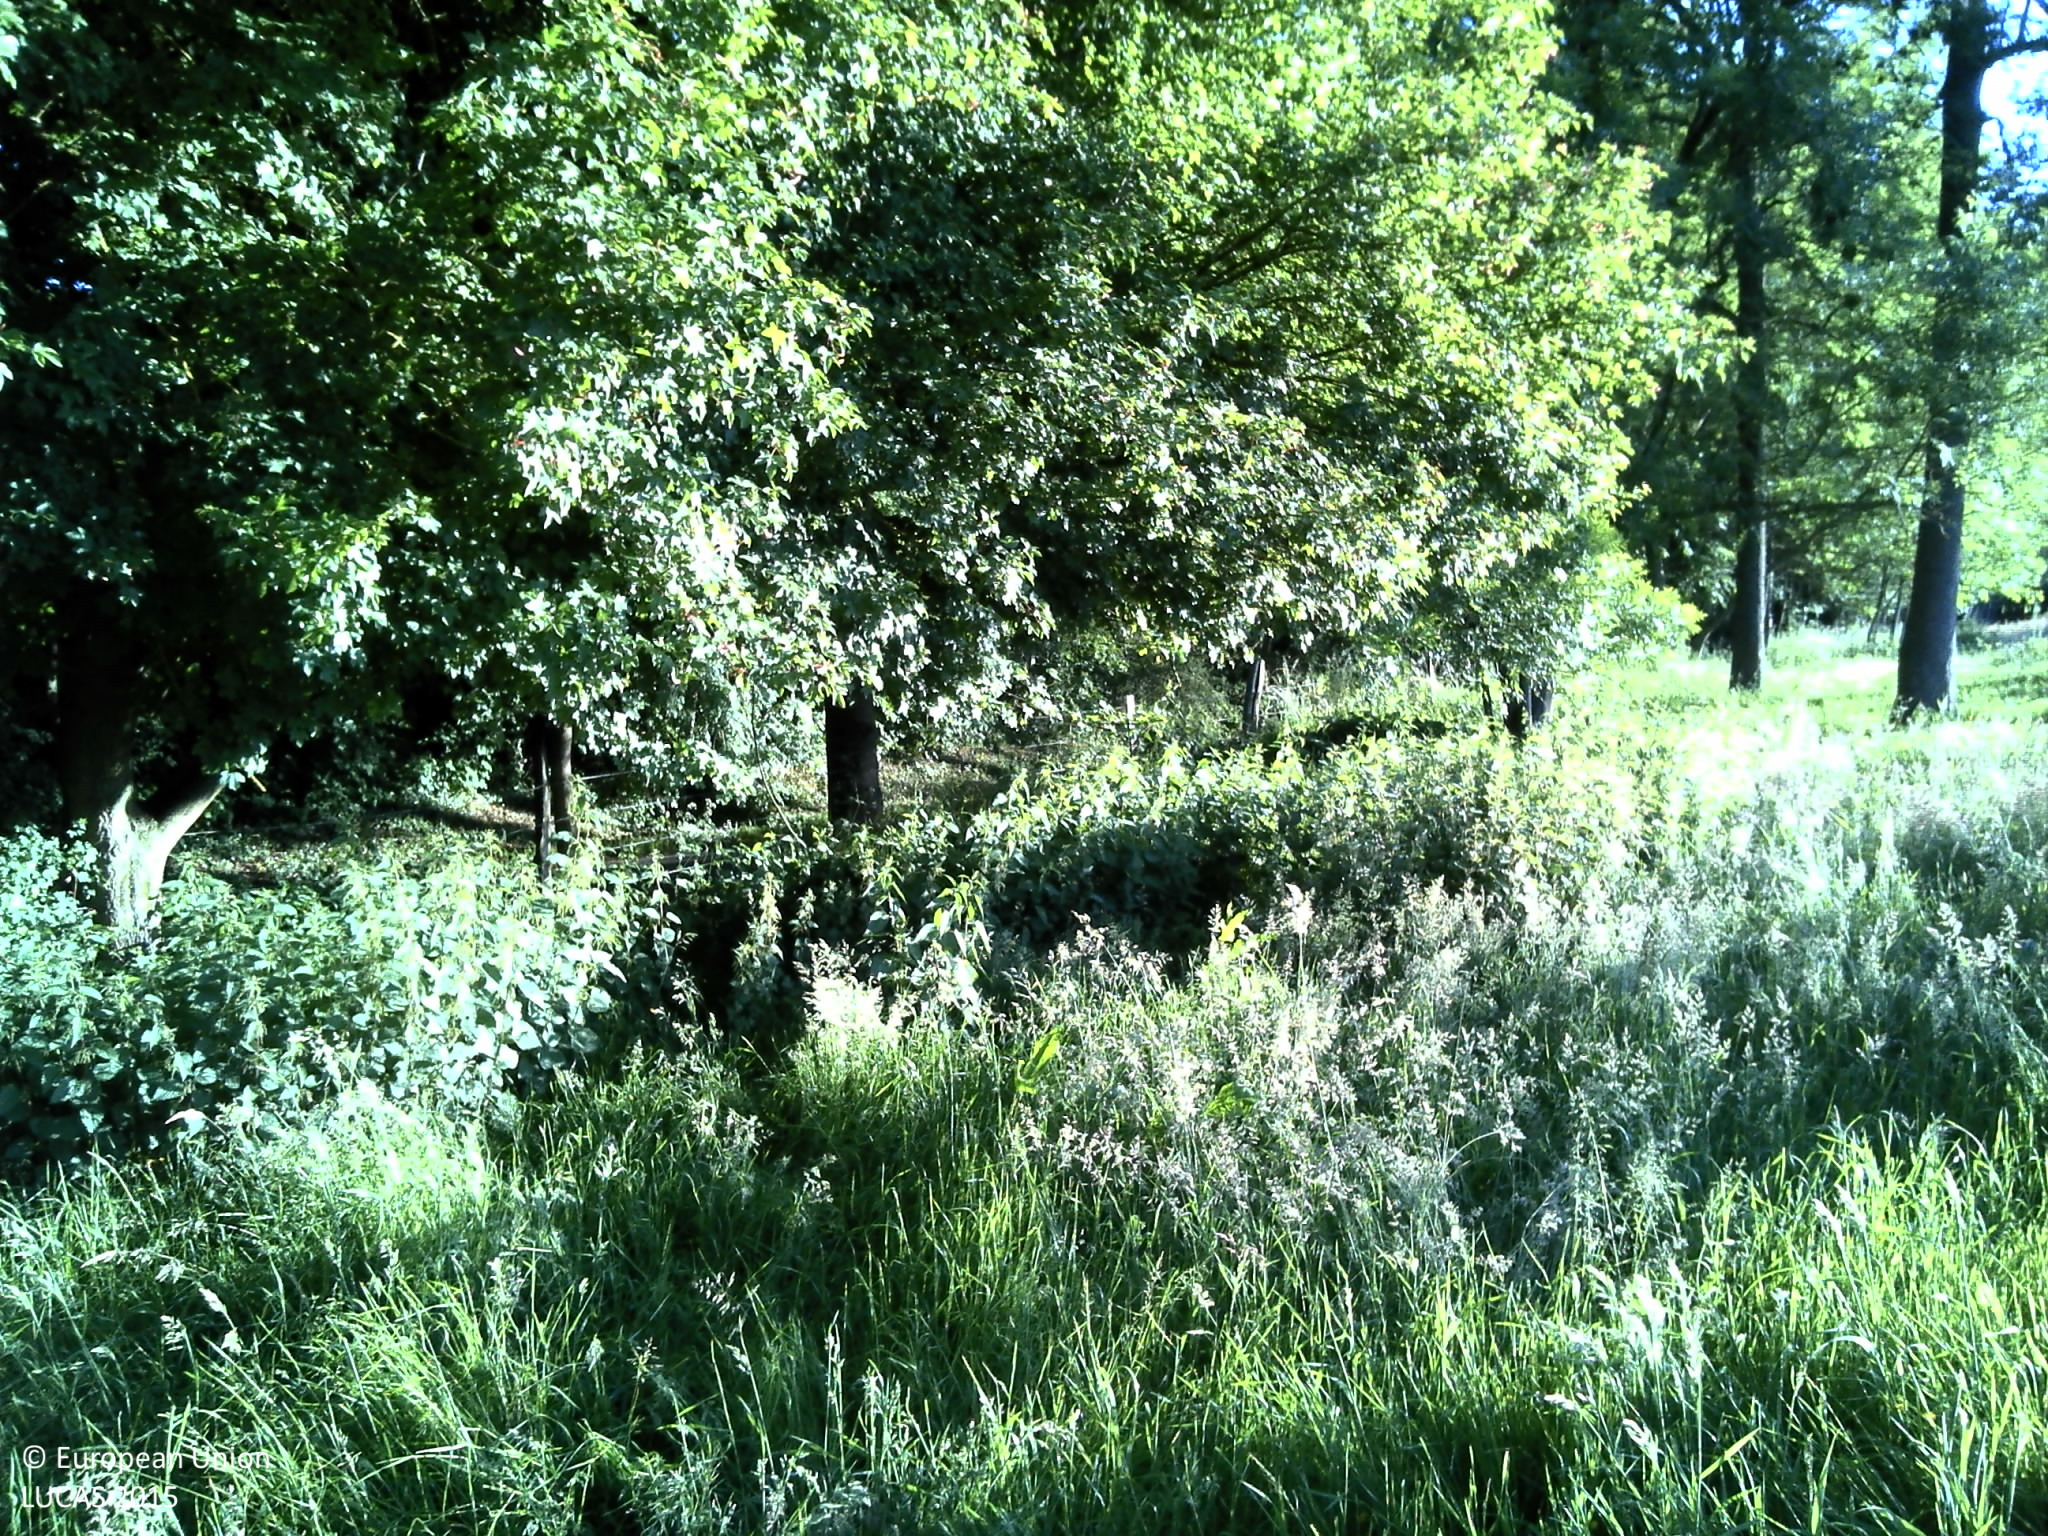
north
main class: Grassland
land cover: Grassland with sparse tree/shrub cover
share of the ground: > 75 %
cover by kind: herbaceous plants 95 %, broadleaved forest trees 5 %
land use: Agriculture (excluding fallow land and kitchen gardens)
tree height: > 5 m
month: June
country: FR
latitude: 49.5902
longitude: 0.9717
